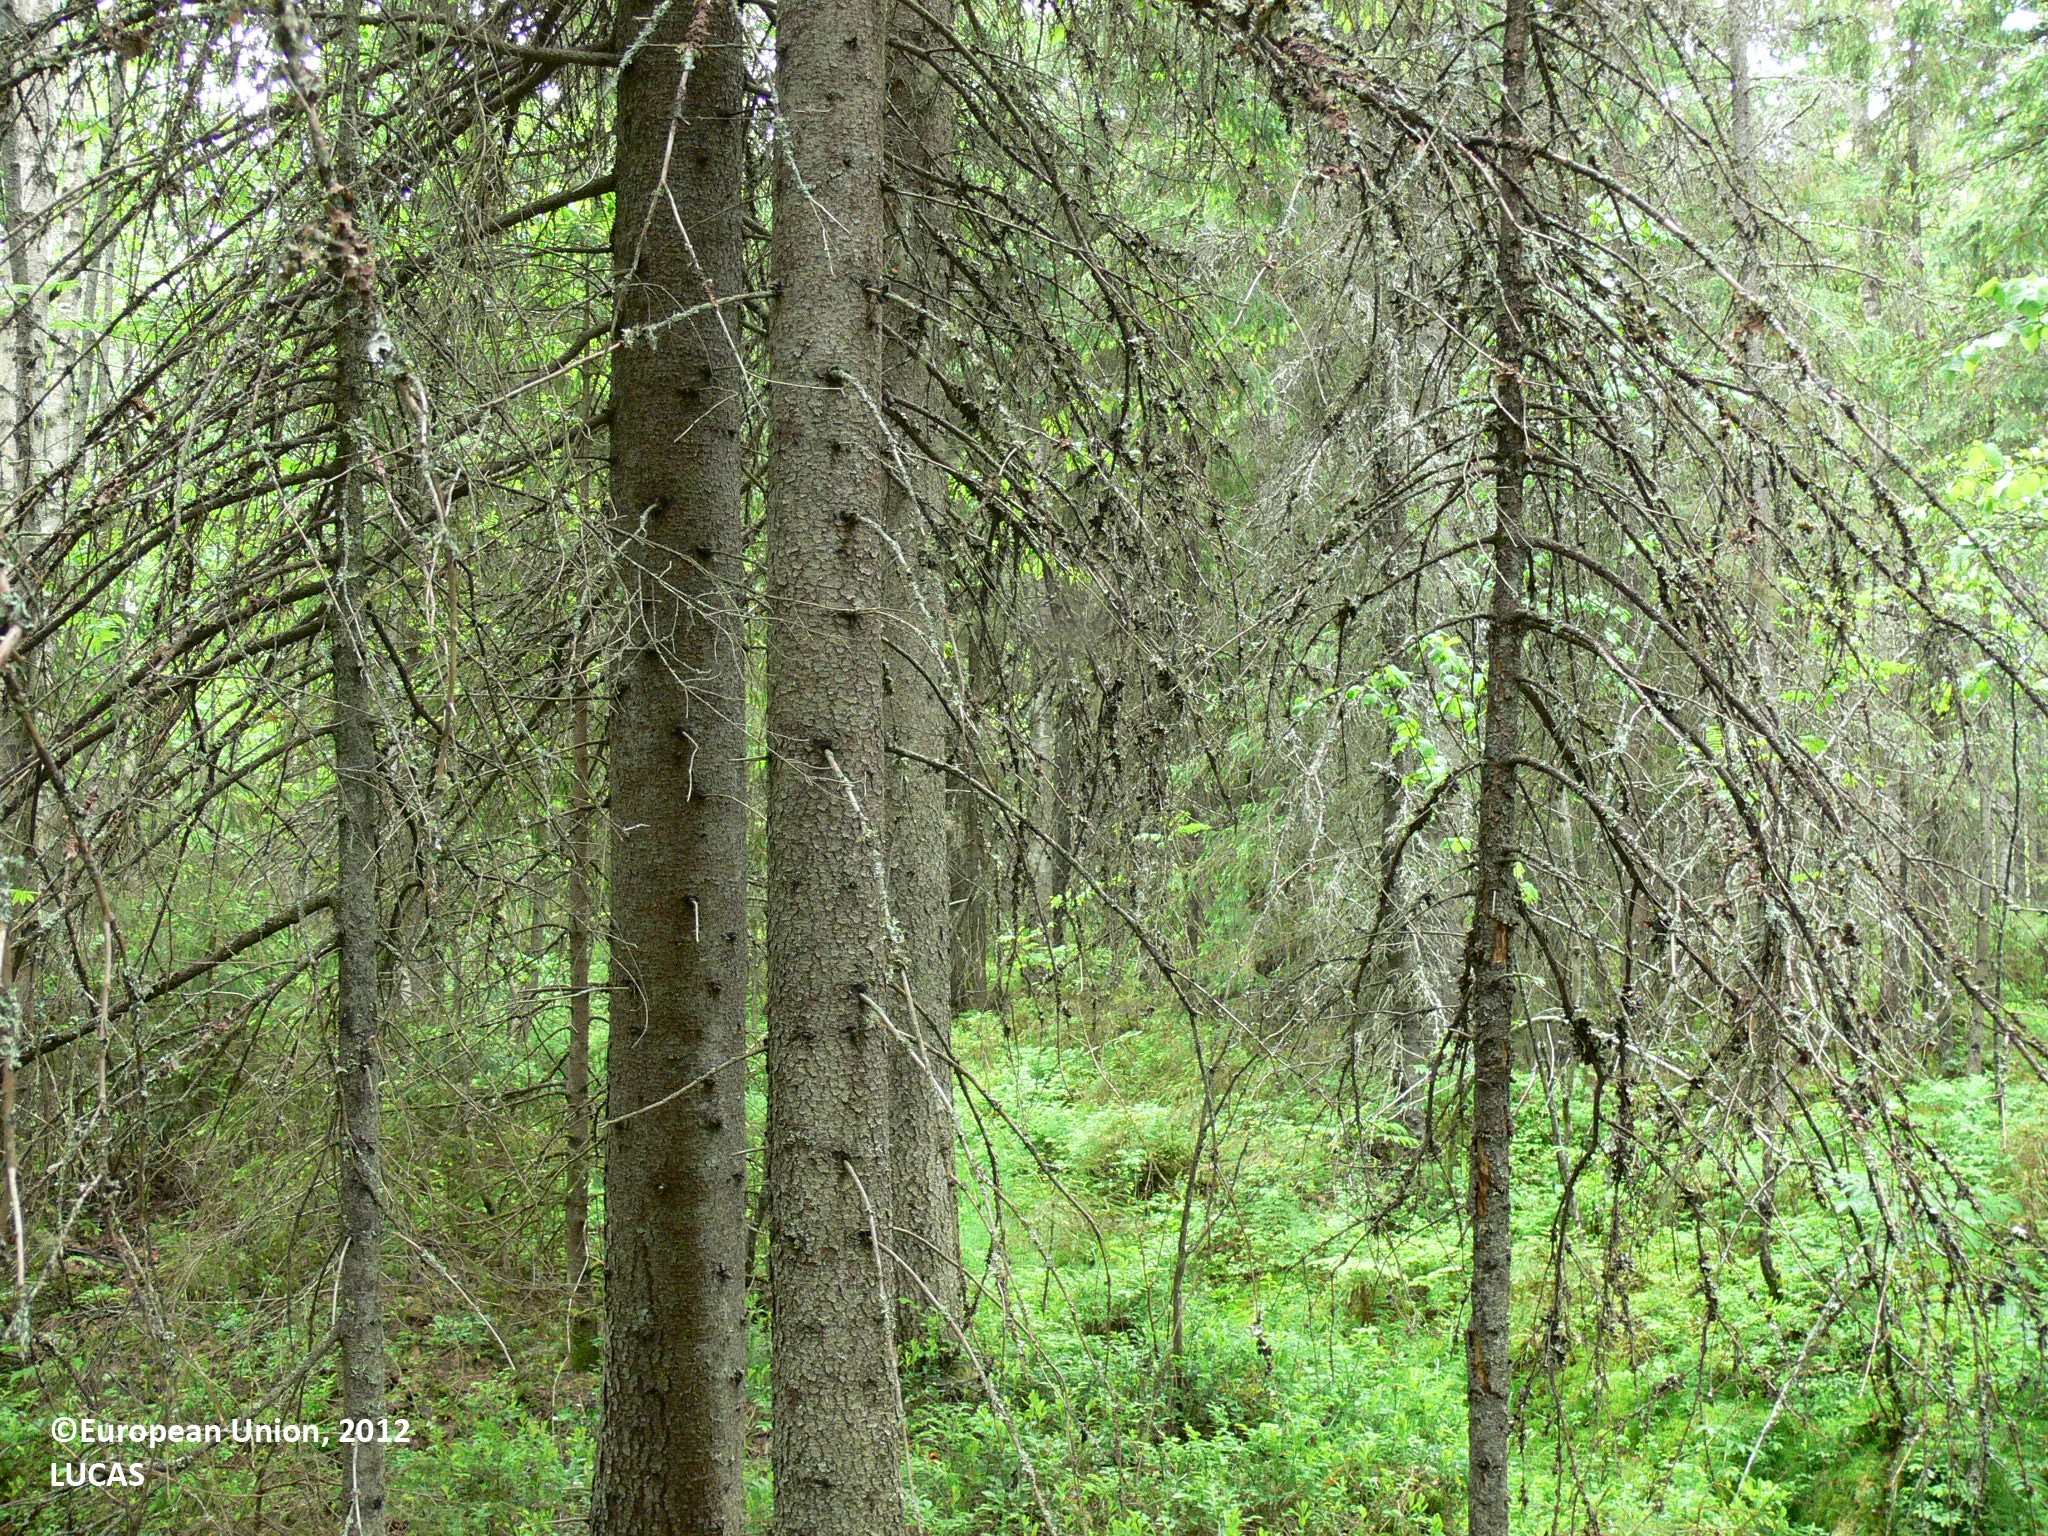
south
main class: Woodland
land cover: Spruce dominated coniferous woodland
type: boreal forest
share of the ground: > 75 %
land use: Forestry
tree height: > 5 m
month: June
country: FI
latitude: 62.8603
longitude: 29.8402
